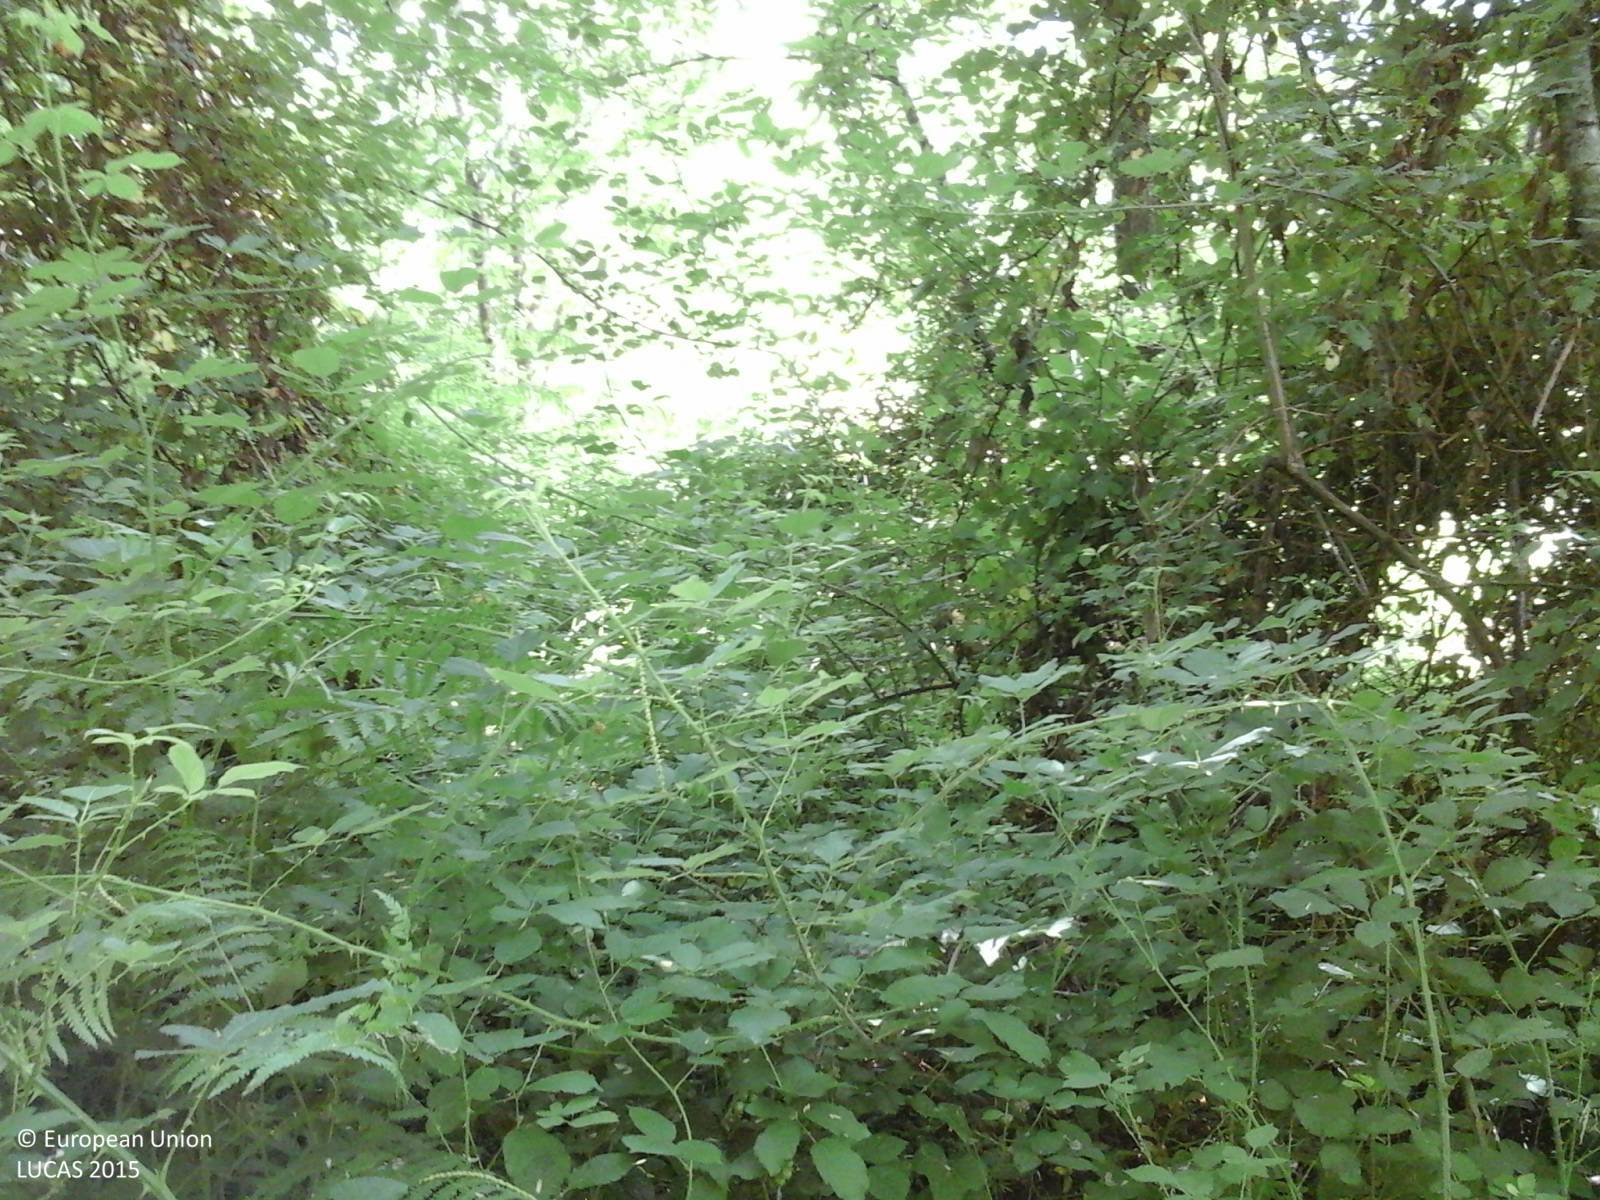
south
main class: Woodland
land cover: Broadleaved woodland
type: thermophilous deciduous forest
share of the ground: > 75 %
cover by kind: broadleaved forest trees 100 %
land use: Forestry
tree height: > 5 m
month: June
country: IT
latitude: 44.1699
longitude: 10.2370
